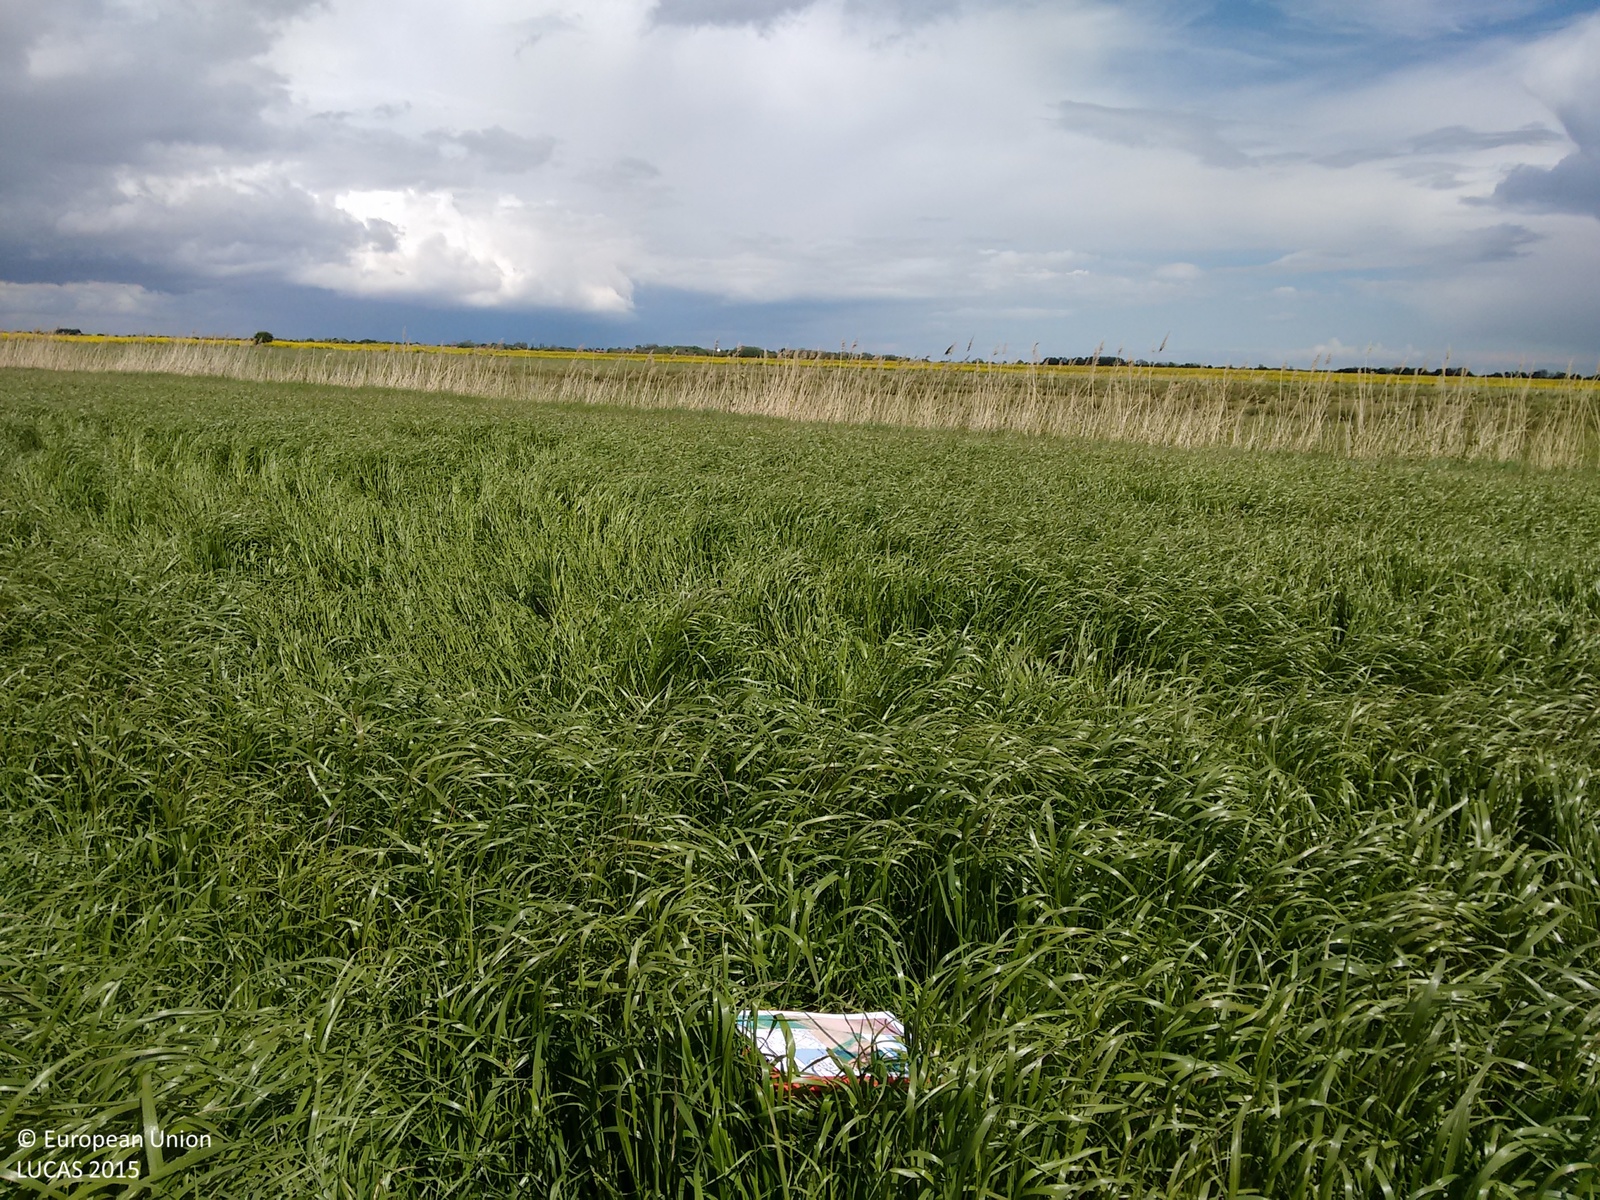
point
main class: Cropland
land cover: Common wheat
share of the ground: > 75 %
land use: Agriculture (excluding fallow land and kitchen gardens)
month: May
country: GB
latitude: 53.4004
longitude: 0.1789
